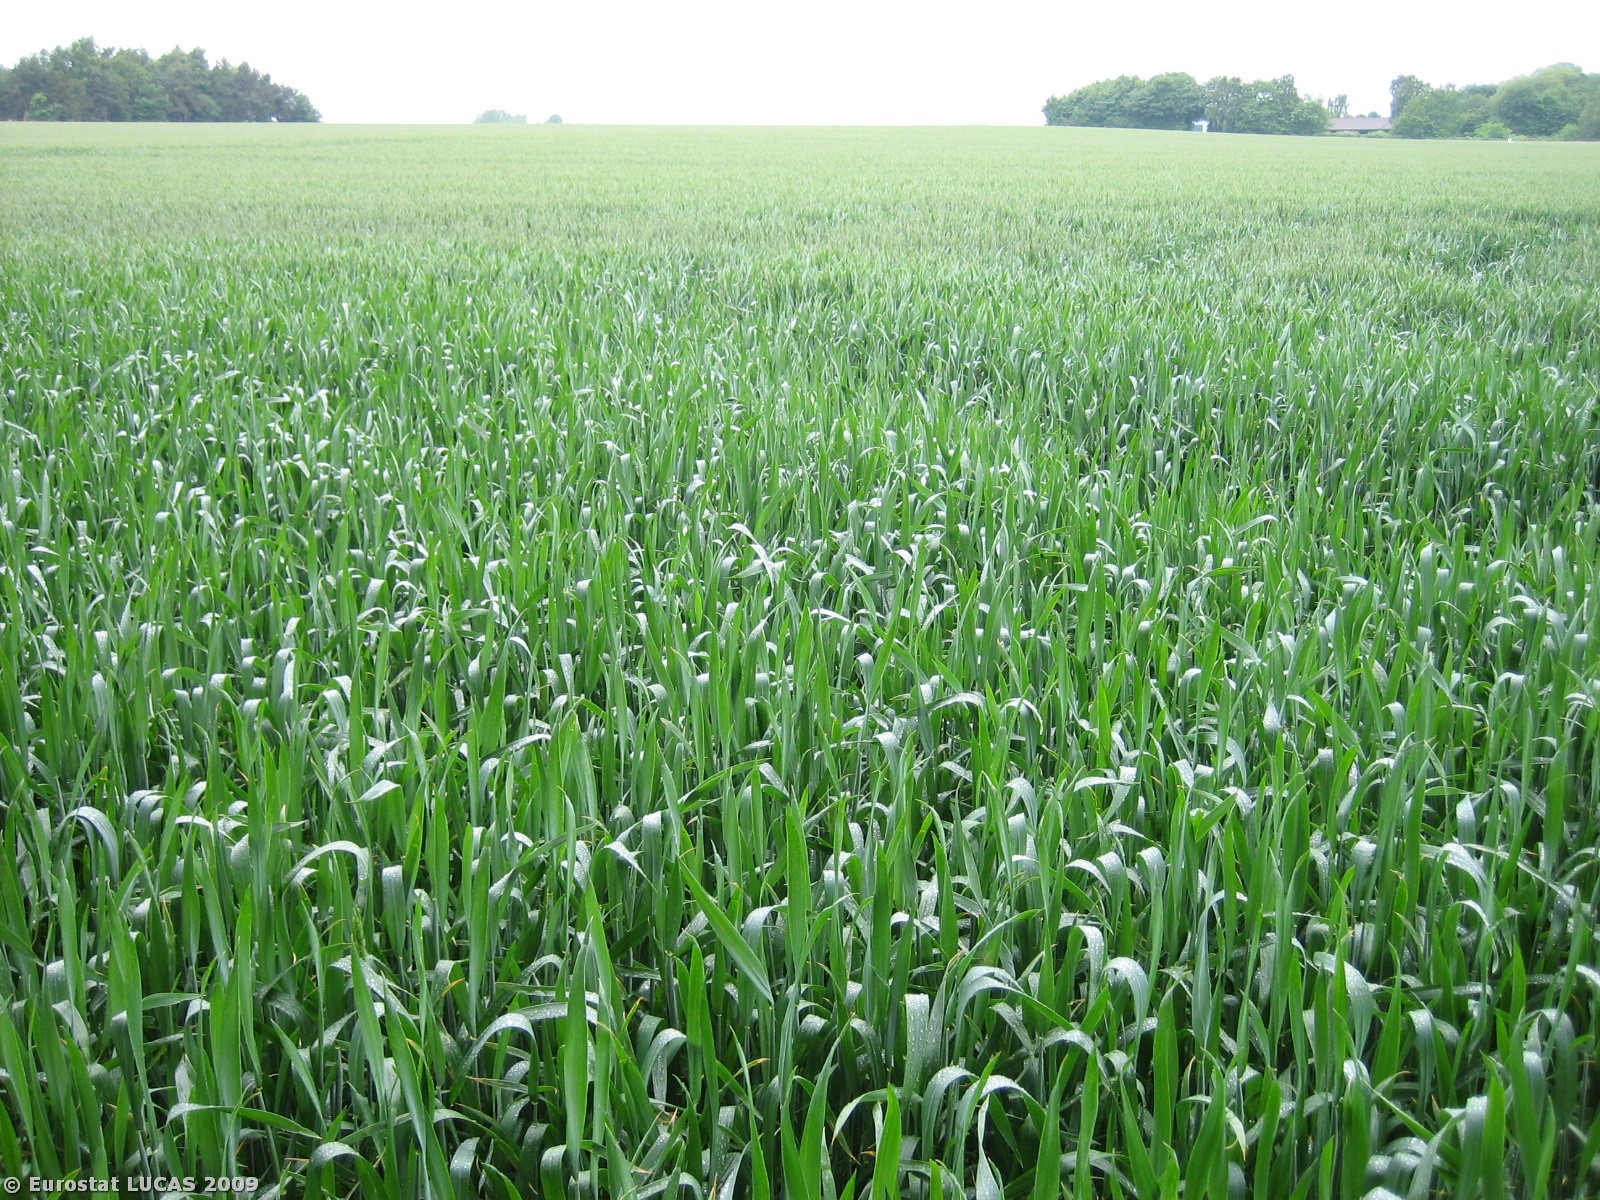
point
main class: Cropland
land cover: Common wheat
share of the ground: > 75 %
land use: Agriculture (excluding fallow land and kitchen gardens)
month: June
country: DK
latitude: 55.9719
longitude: 10.2081
